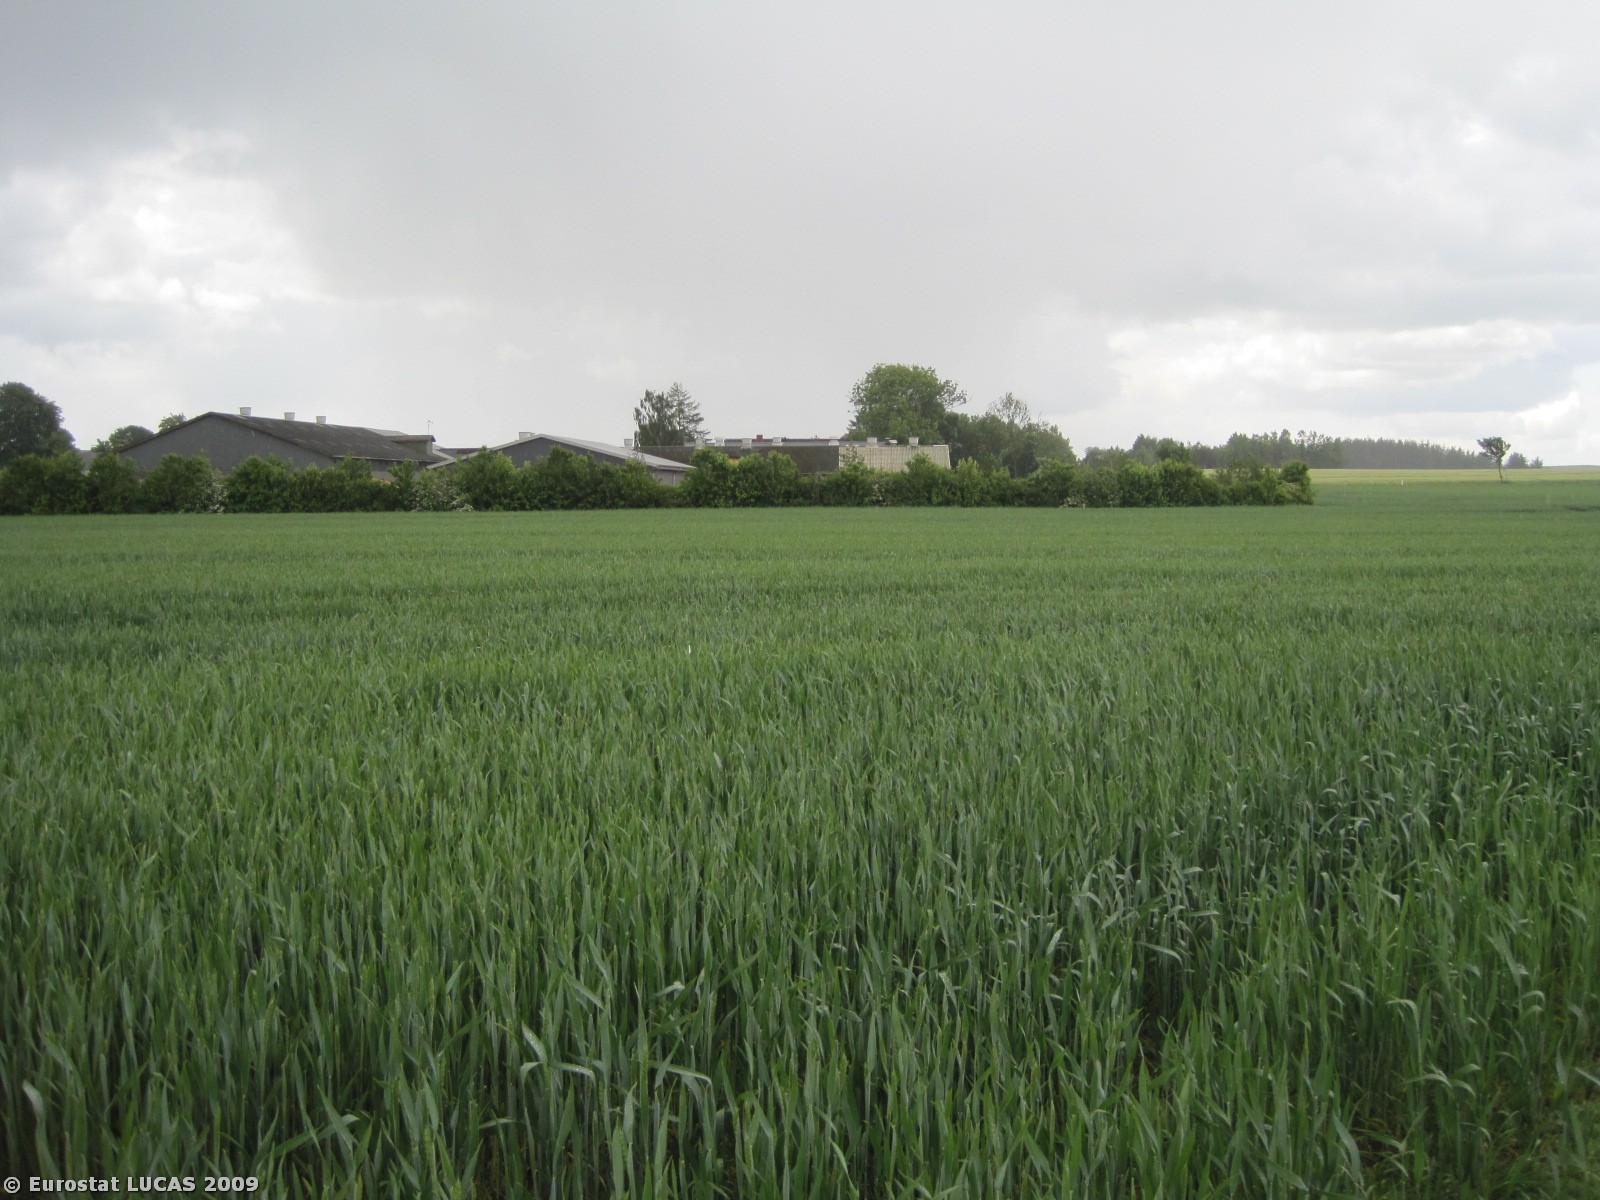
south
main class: Cropland
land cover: Common wheat
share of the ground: > 75 %
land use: Agriculture (excluding fallow land and kitchen gardens)
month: June
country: DK
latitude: 56.9426
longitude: 9.7866
